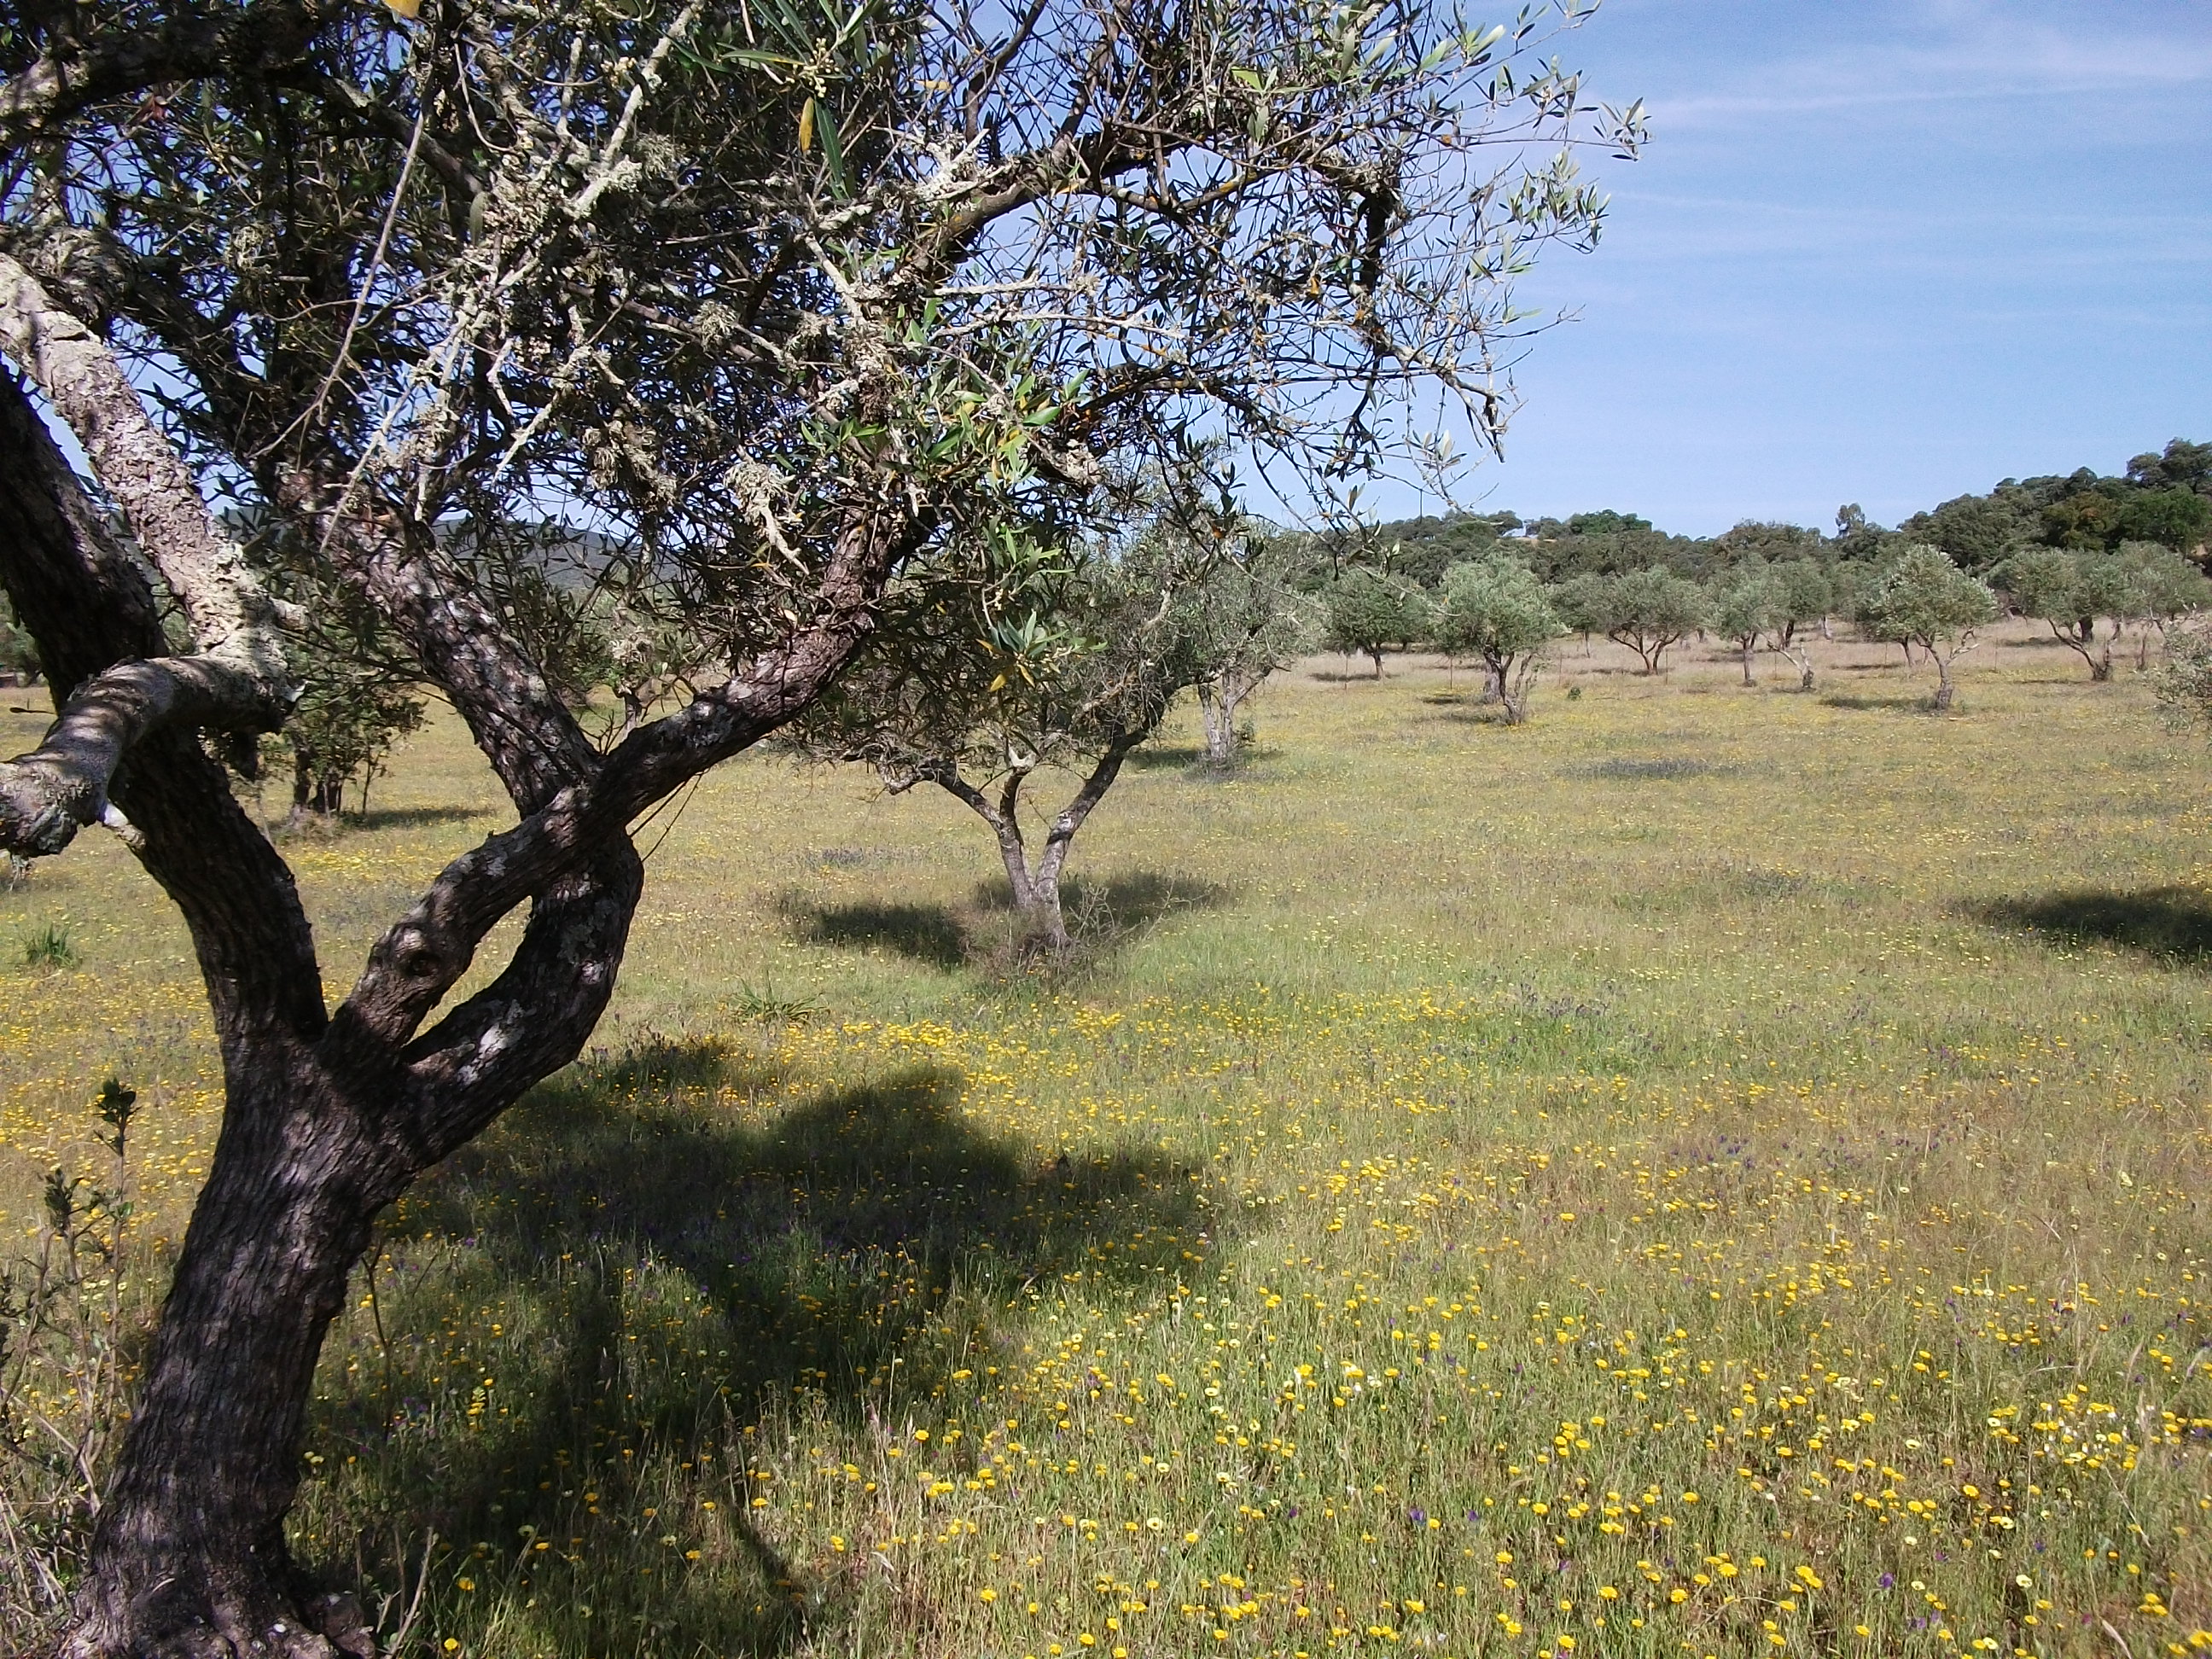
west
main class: Cropland
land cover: Olive groves
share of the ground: 25 - 50 %
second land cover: Spontaneously vegetated surfaces
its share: 50 - 75 %
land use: Agriculture (excluding fallow land and kitchen gardens)
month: May
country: ES
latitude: 37.9719
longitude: -7.2363
